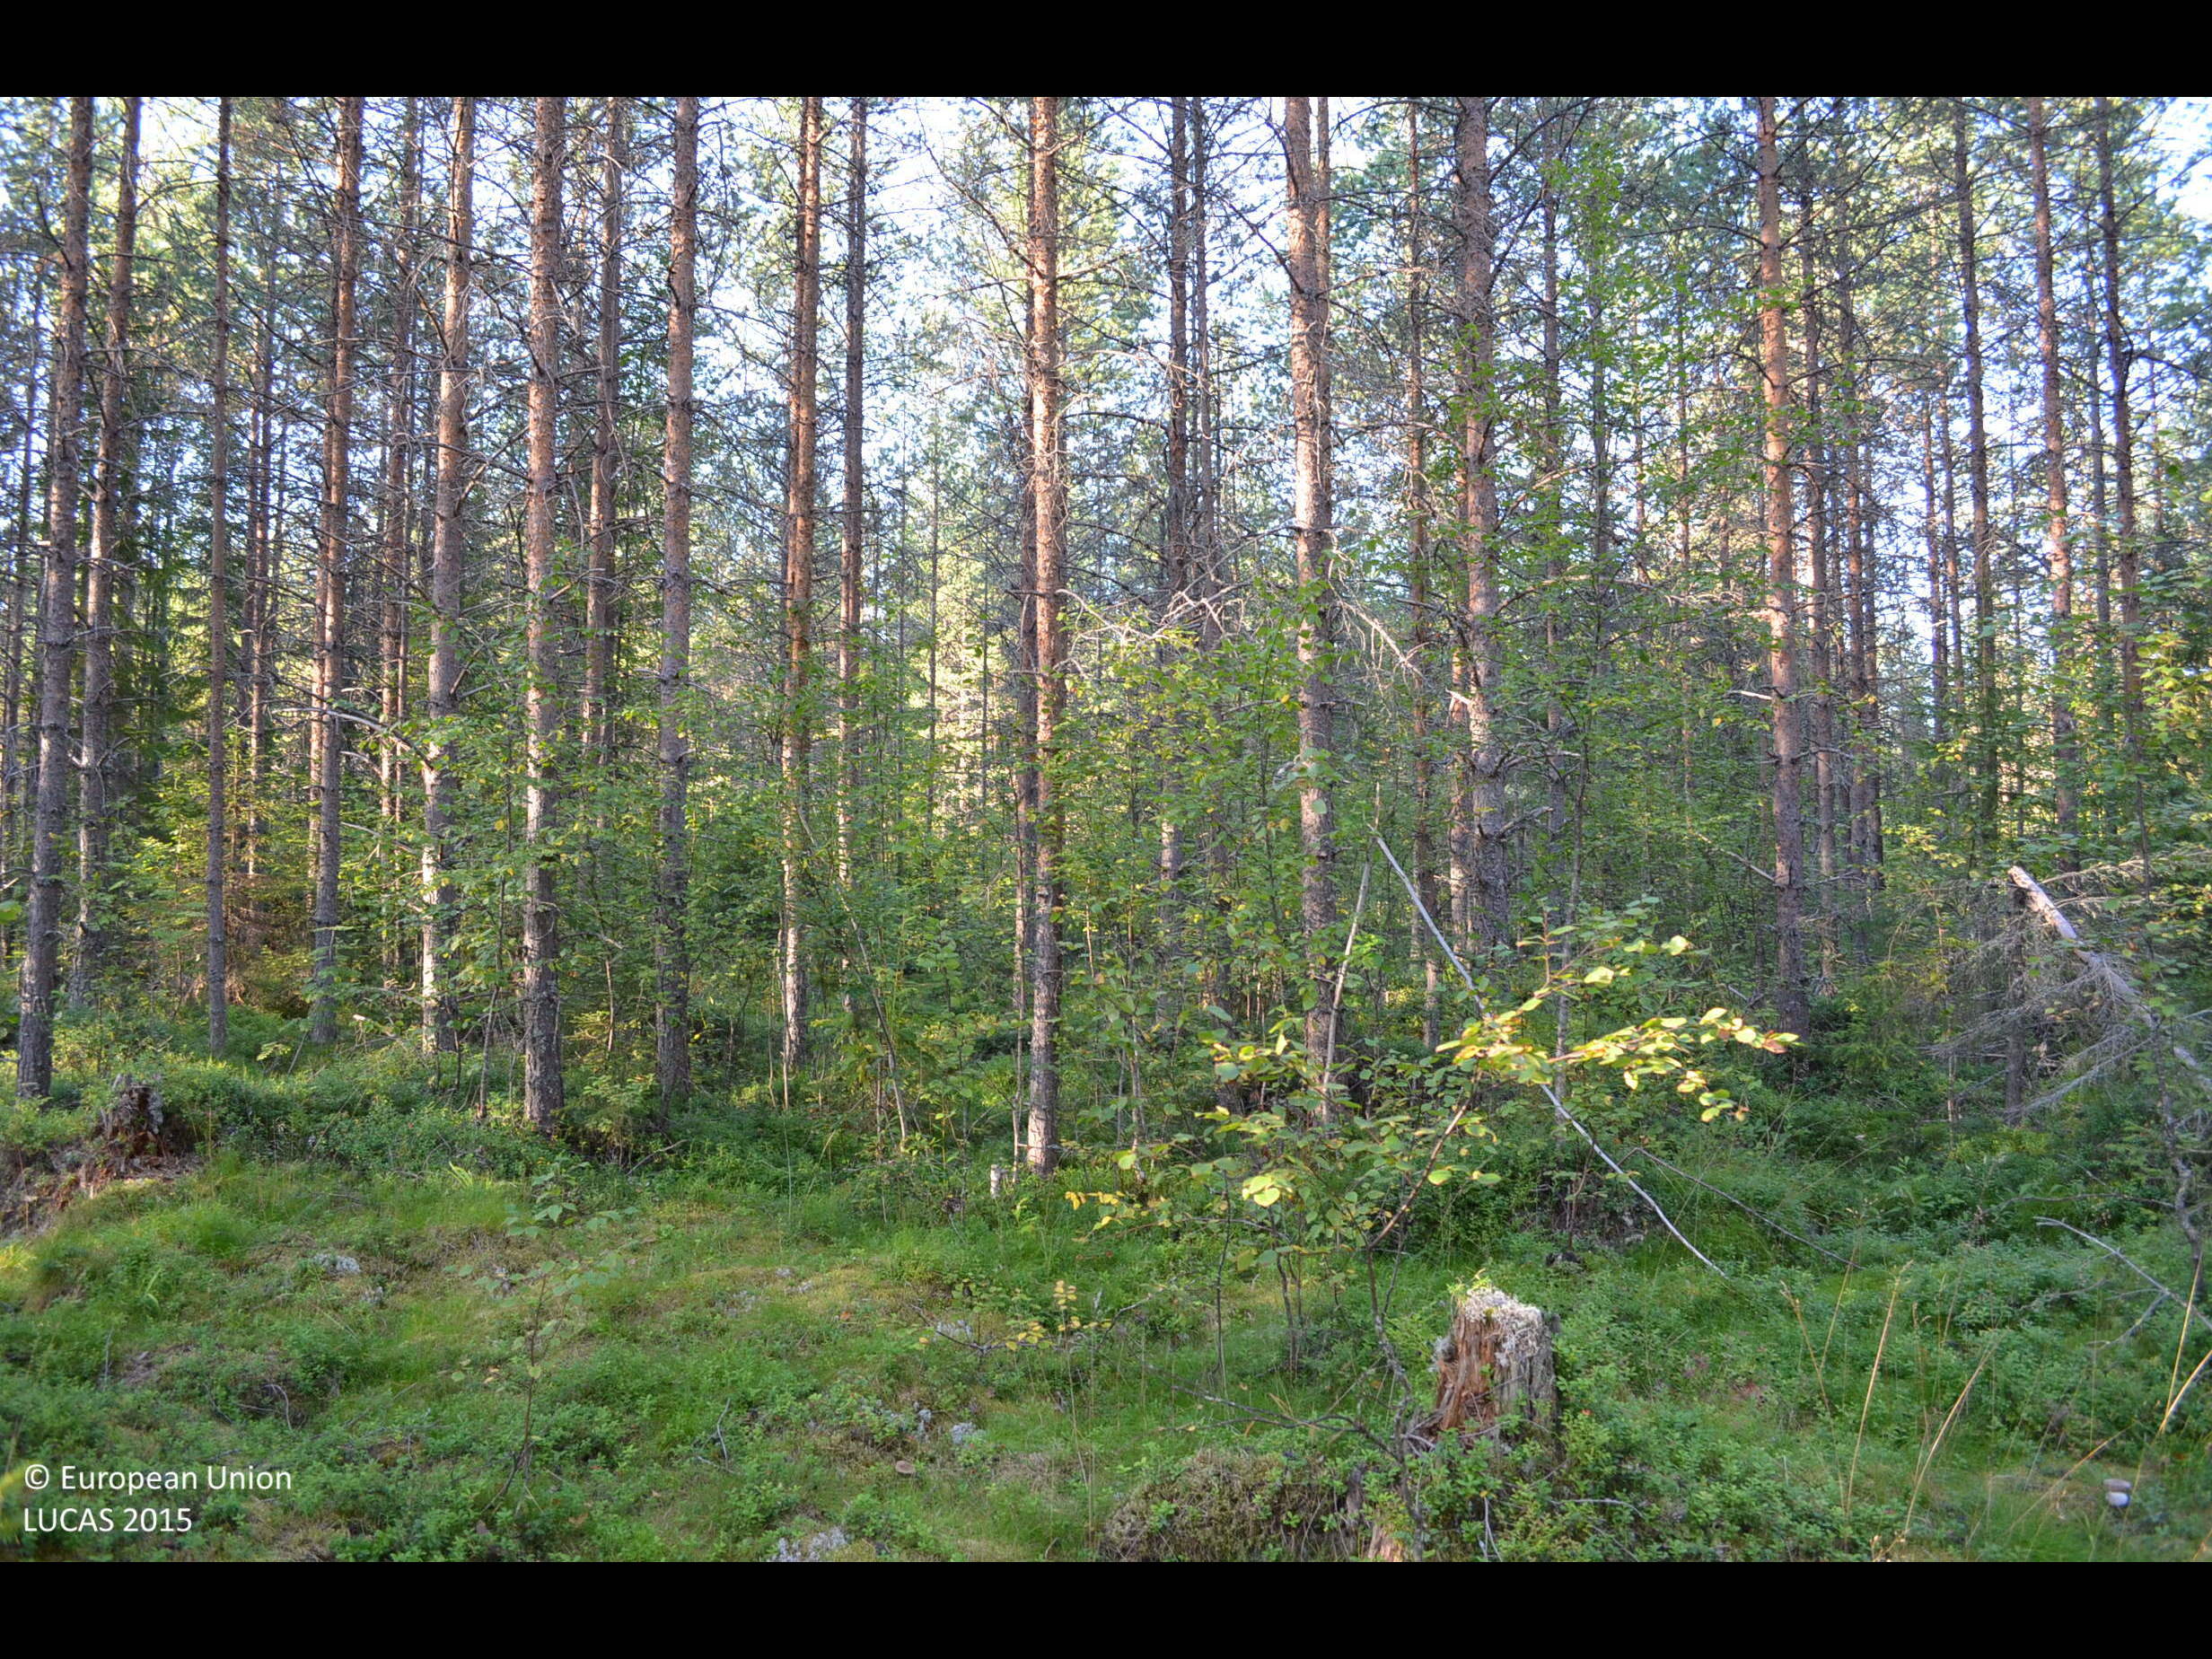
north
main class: Woodland
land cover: Pine dominated coniferous woodland
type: boreal forest
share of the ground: > 75 %
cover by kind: coniferous forest trees 70 %, broadleaved forest trees 10 %, shrubs 10 %, herbaceous plants 10 %
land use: Forestry
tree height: > 5 m
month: August
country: FI
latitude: 62.5316
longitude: 24.4891
